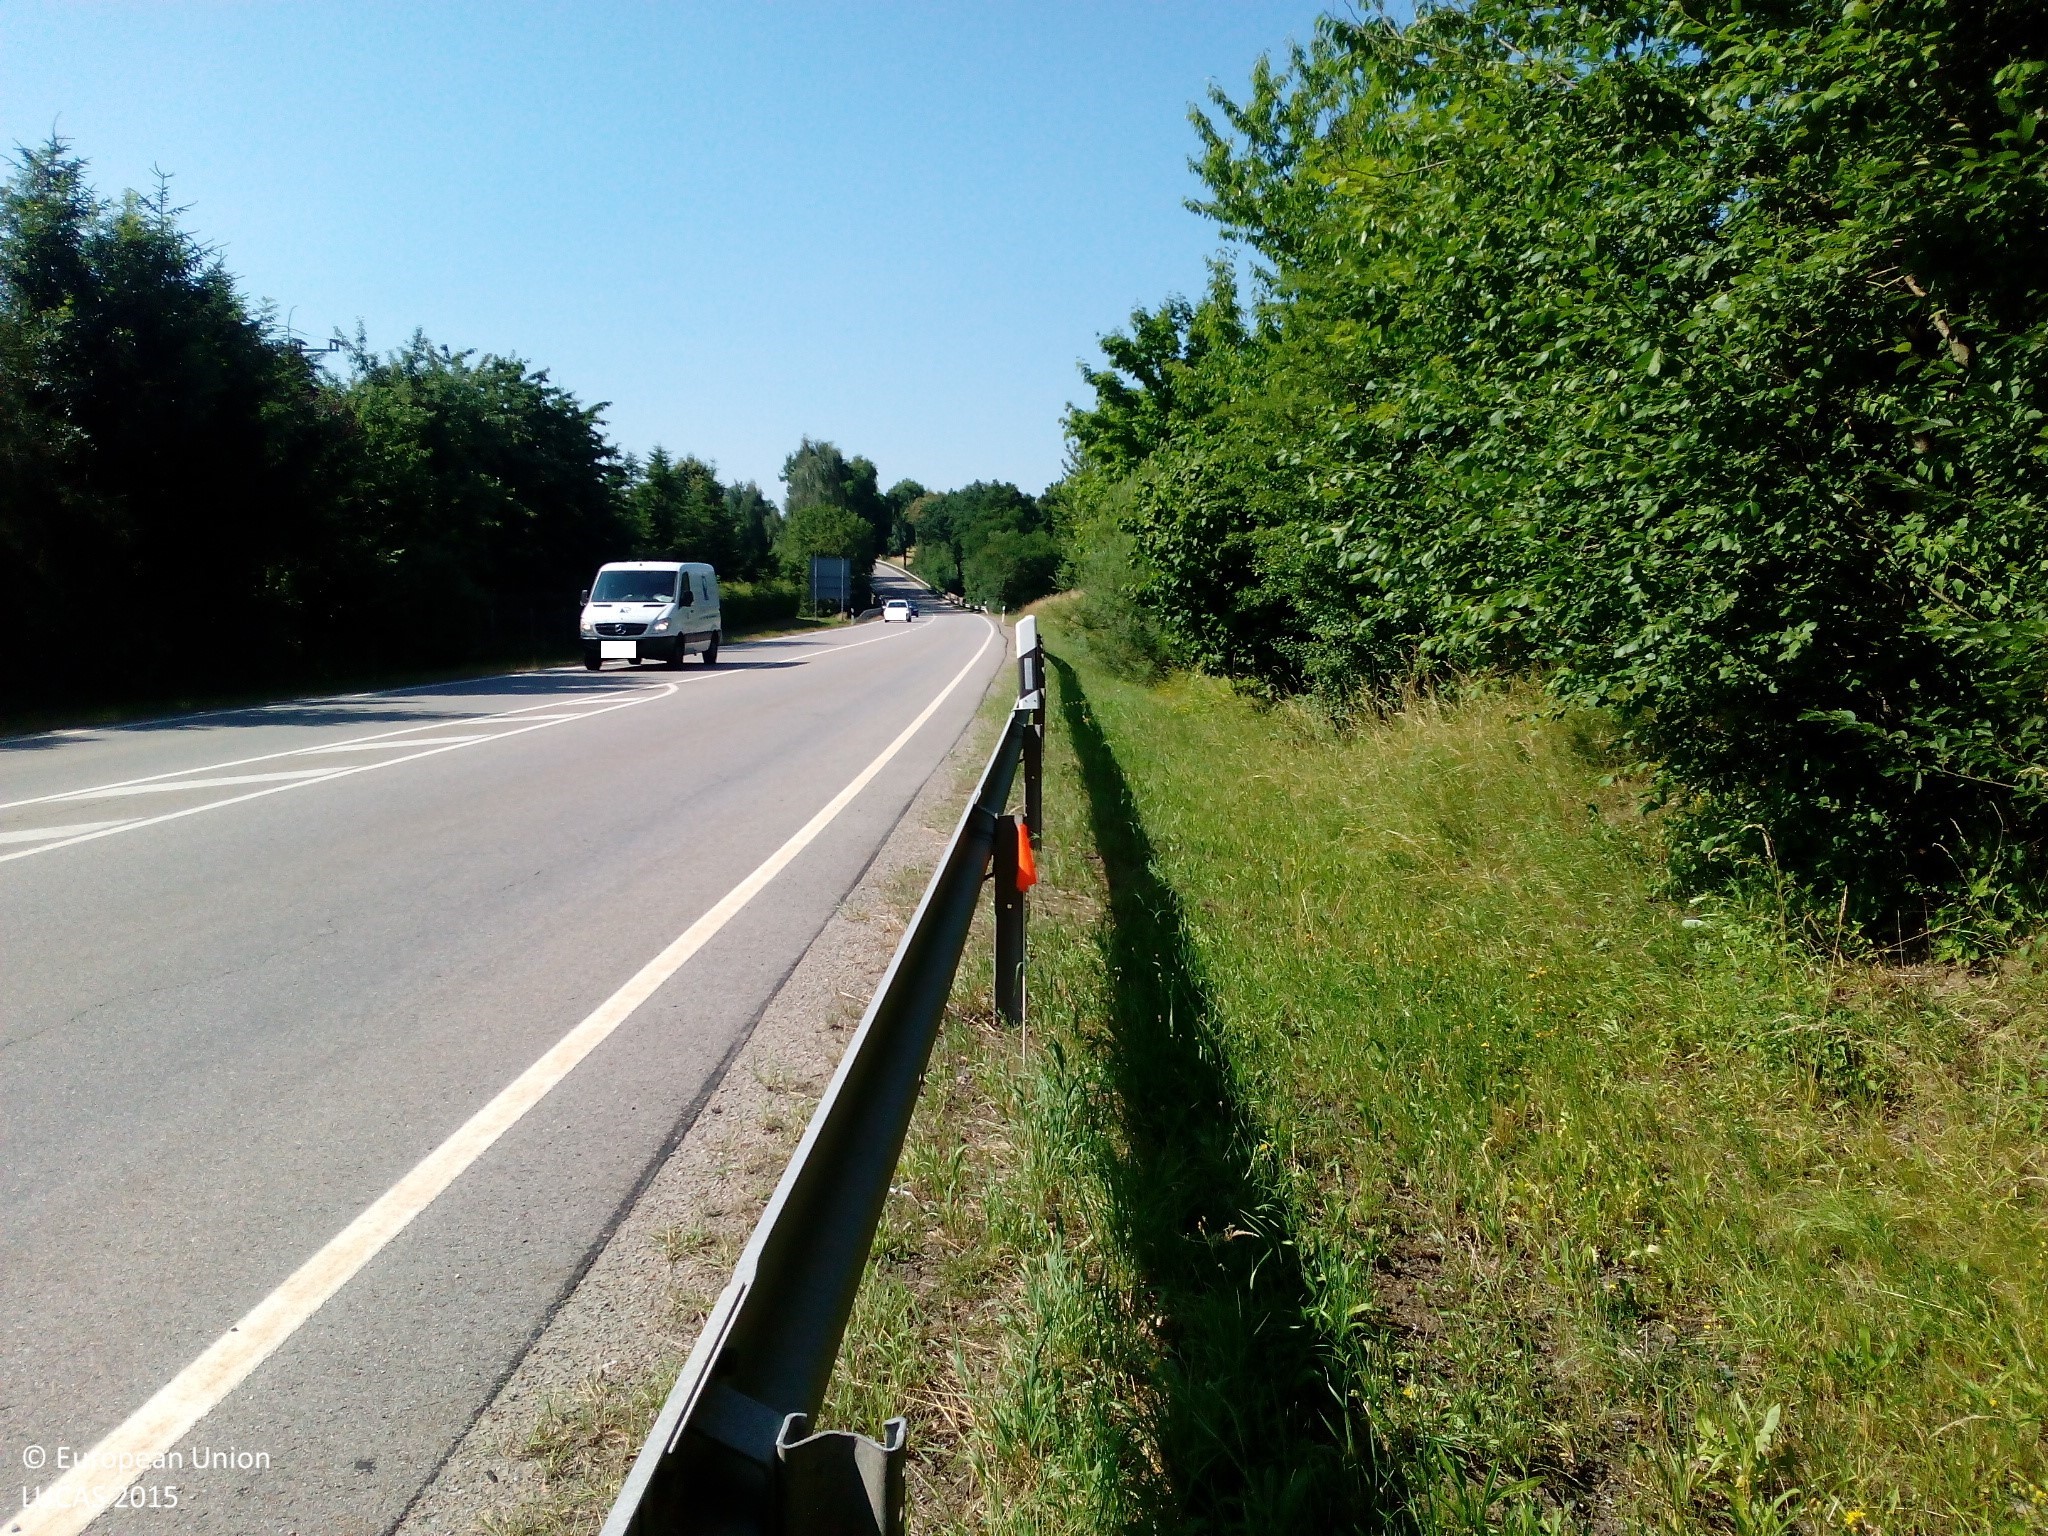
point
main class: Woodland
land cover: Broadleaved woodland
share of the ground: > 75 %
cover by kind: broadleaved forest trees 90 %, herbaceous plants 10 %
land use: Road transport
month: July
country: DE
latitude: 49.6228
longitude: 12.2282
